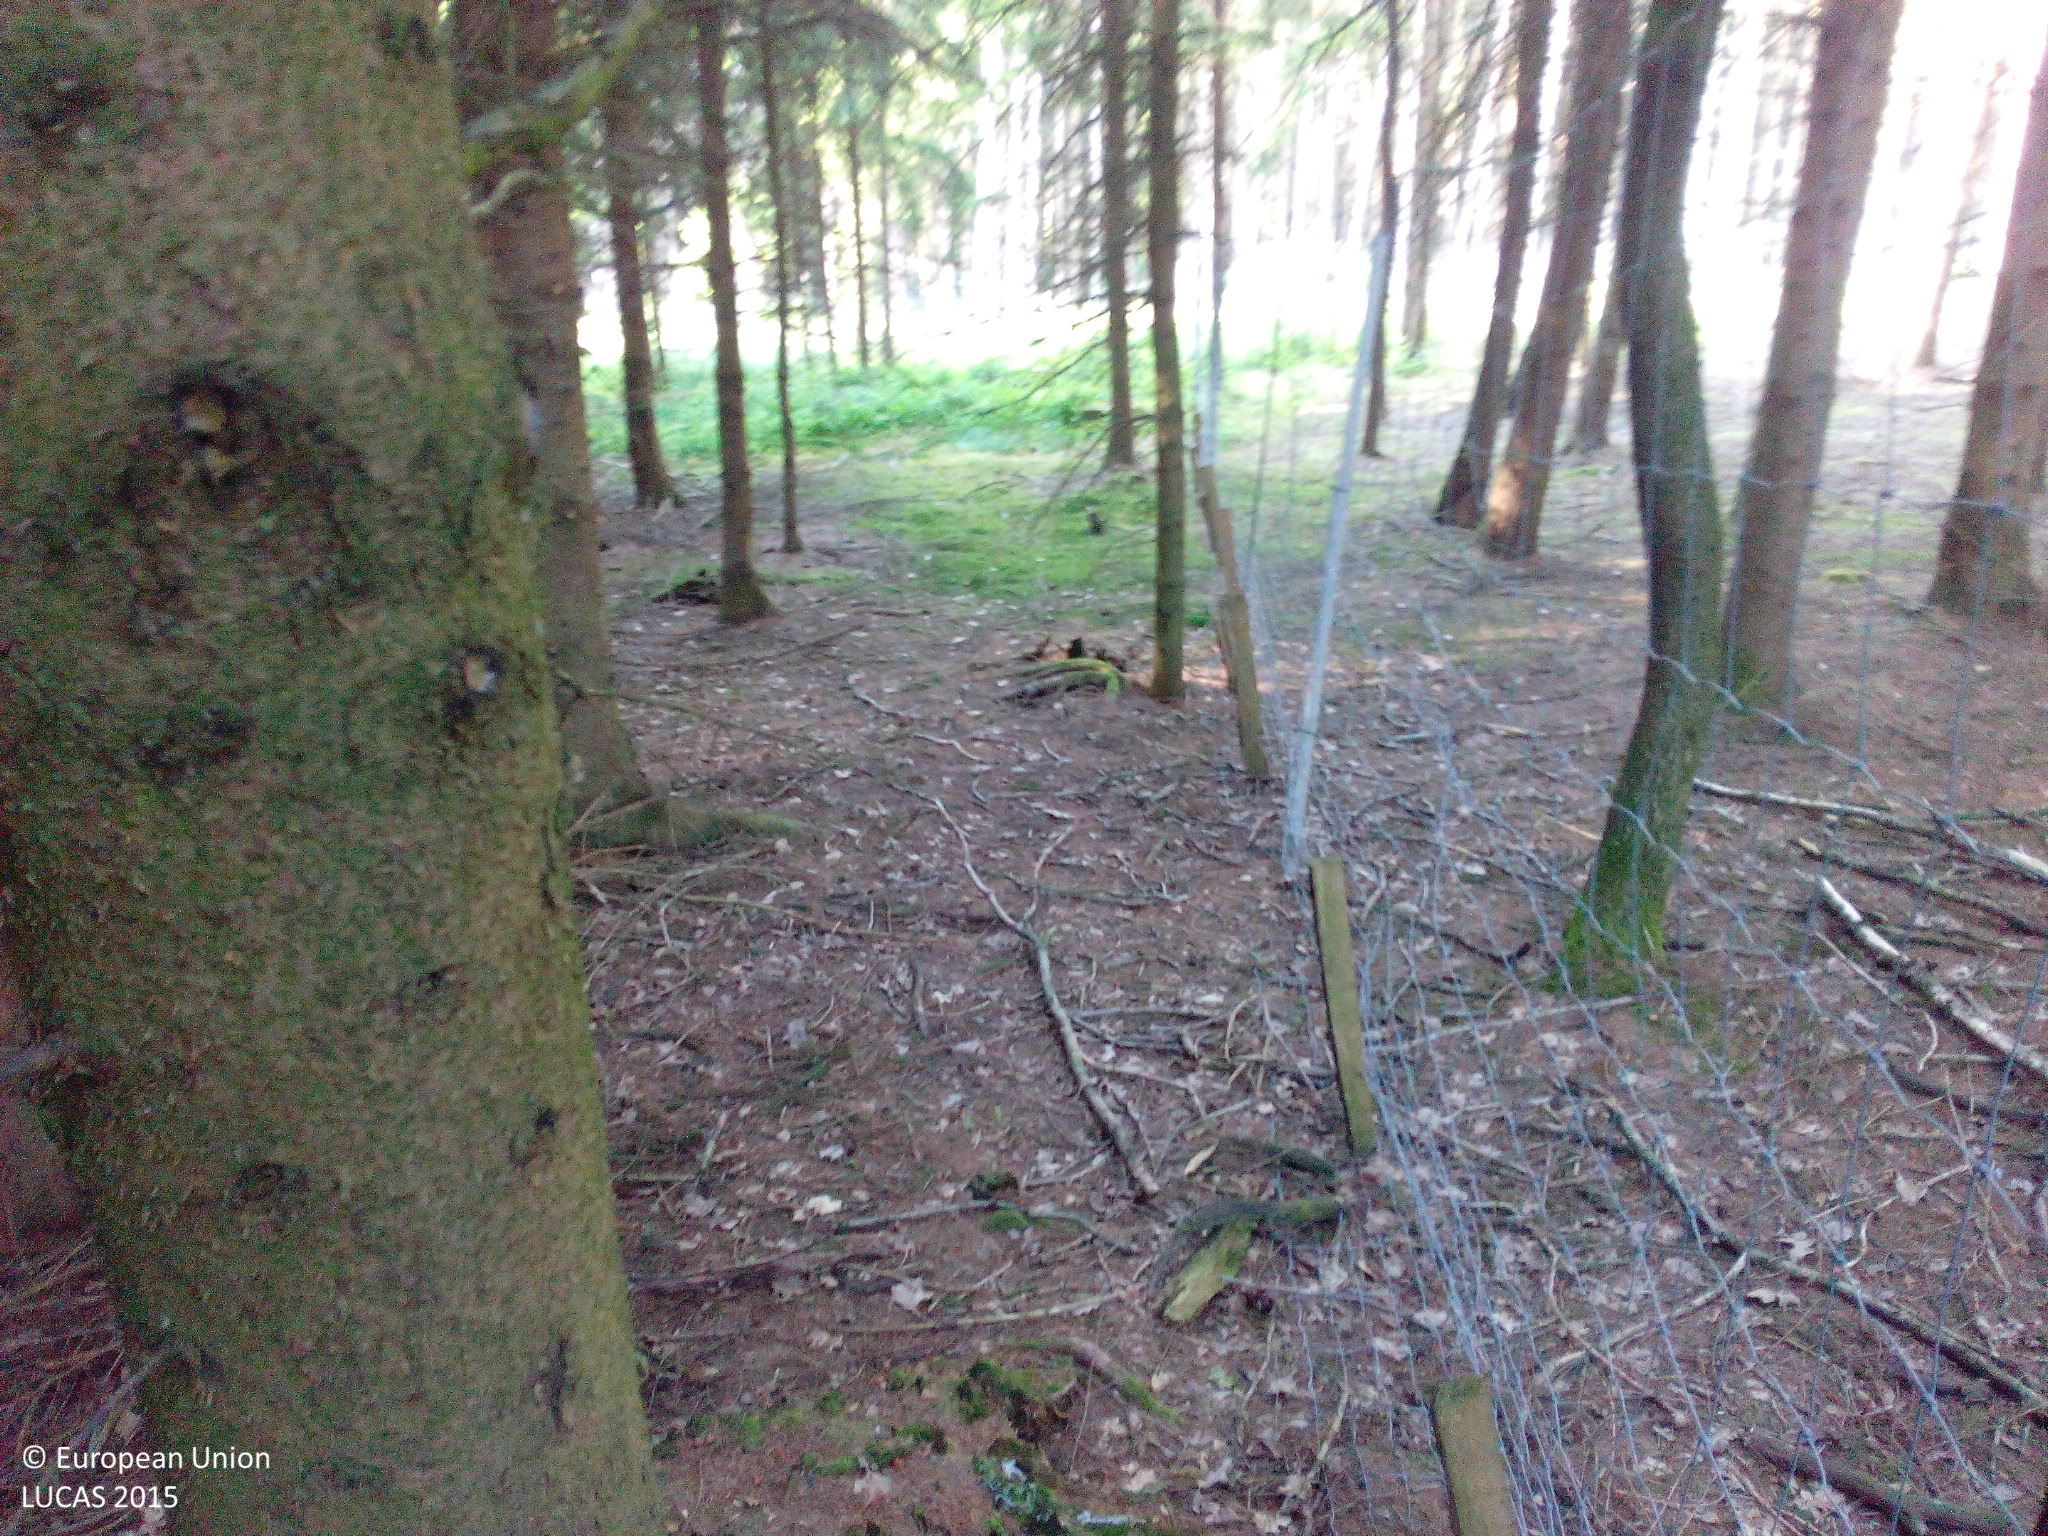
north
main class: Woodland
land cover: Spruce dominated coniferous woodland
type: hemiboreal forest and nemoral coniferous forest and mixed broadleaved-coniferous forest
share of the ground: > 75 %
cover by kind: coniferous forest trees 95 %, unconsolidated bare surface 5 %
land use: Forestry
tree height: > 5 m
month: May
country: DE
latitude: 48.3636
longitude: 12.1992
